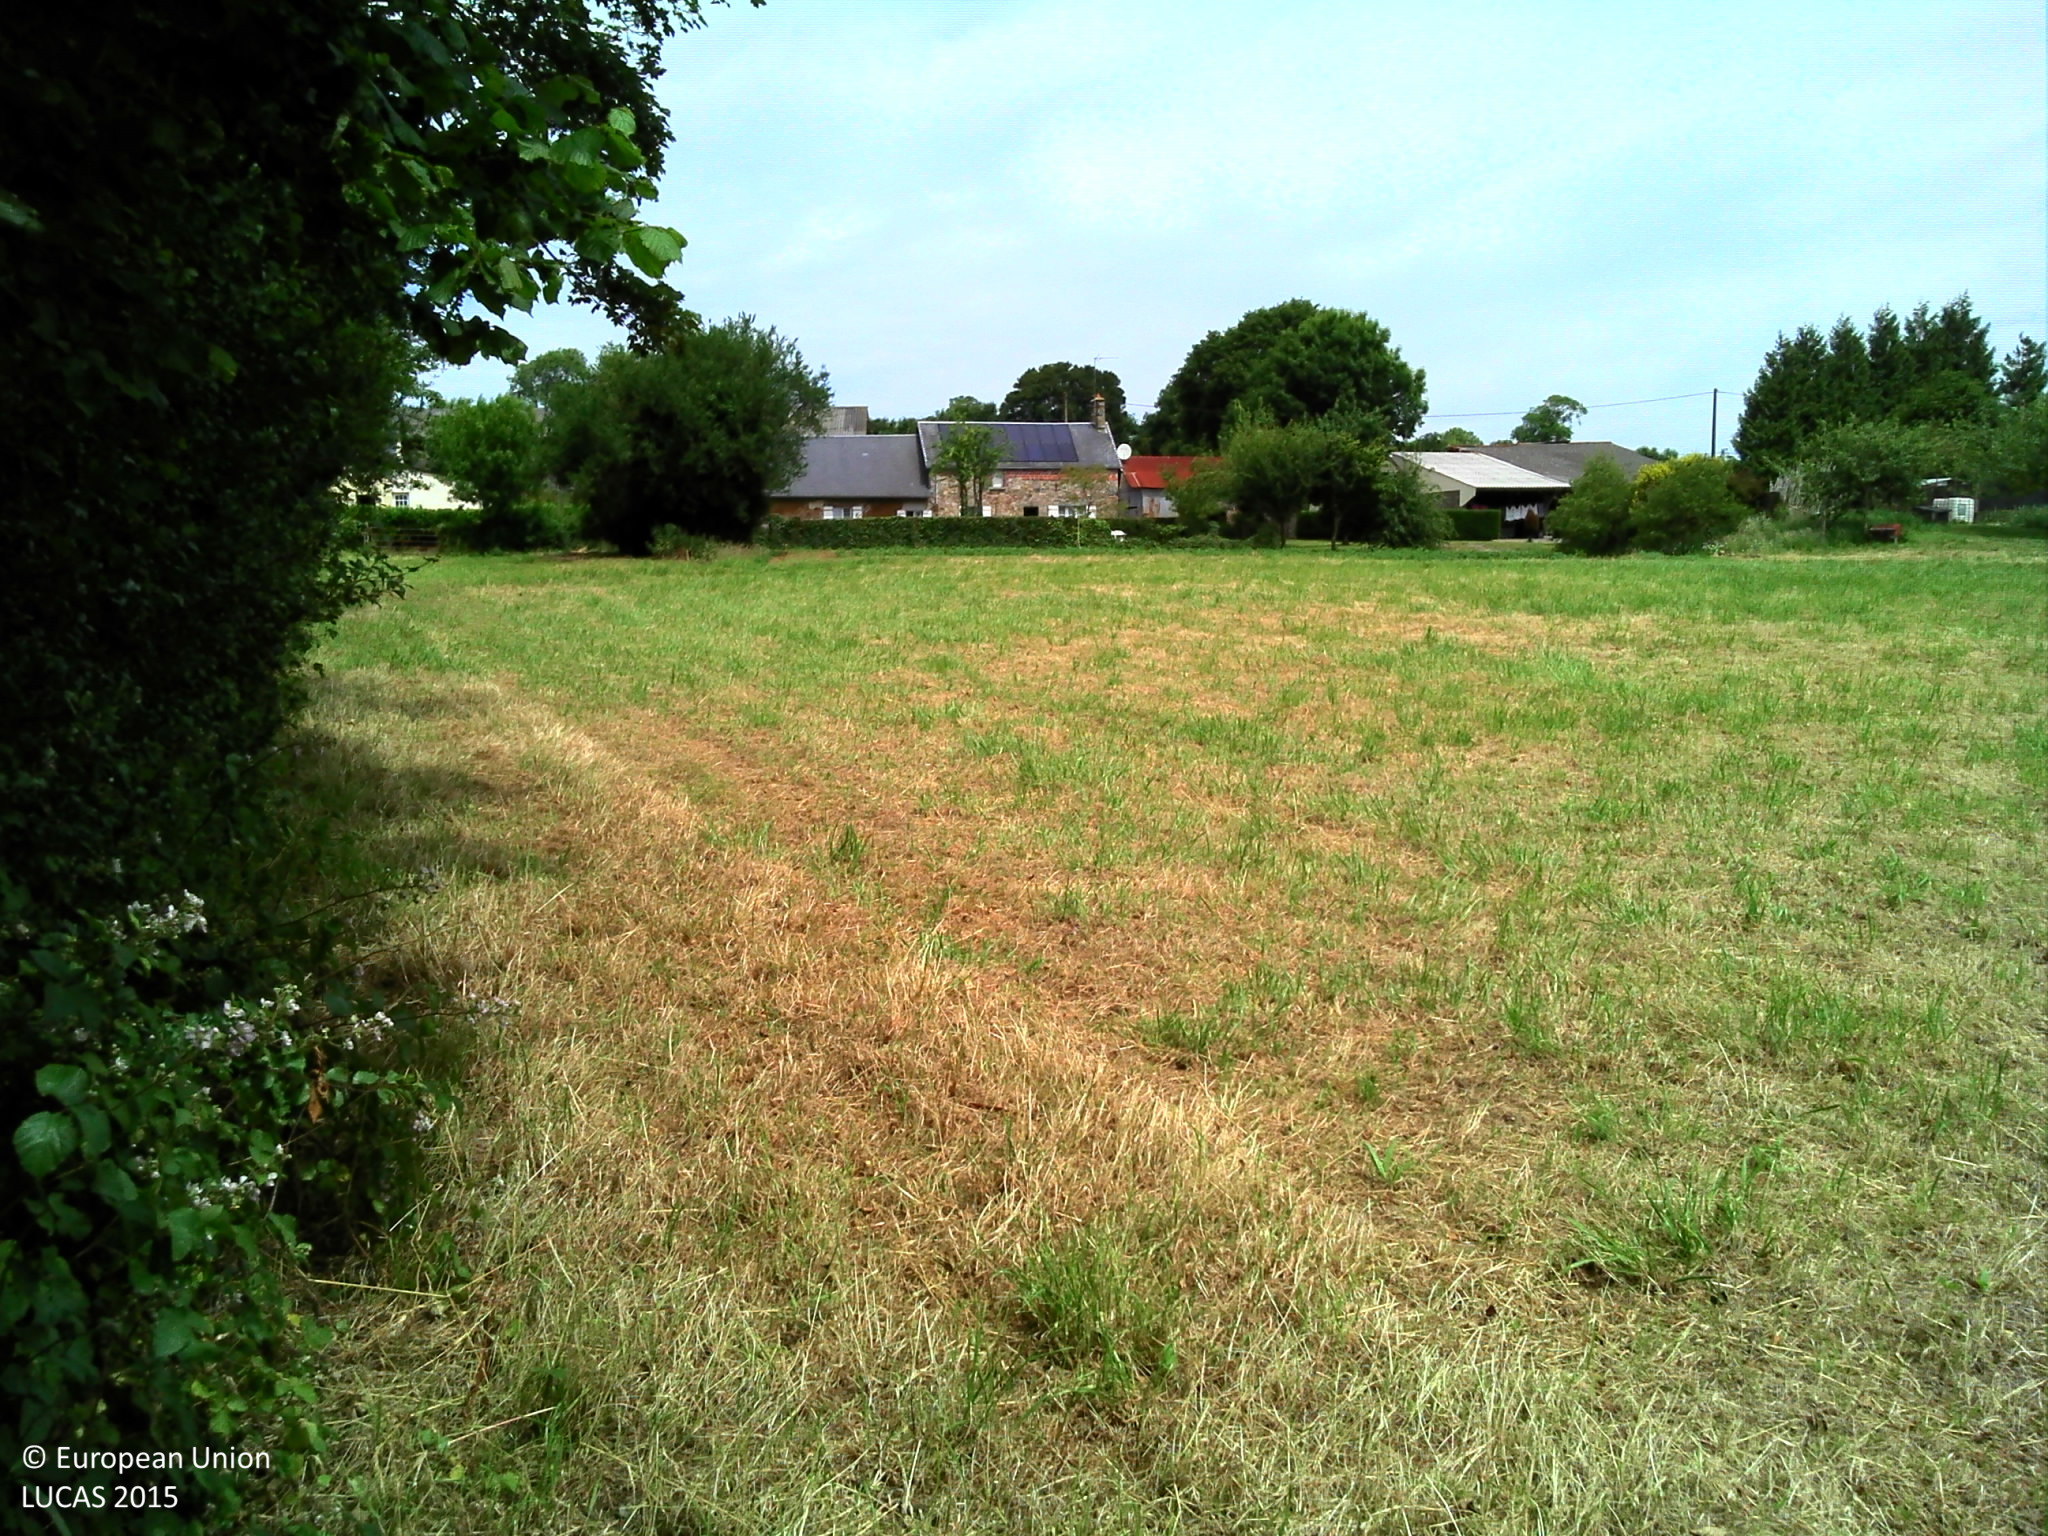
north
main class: Woodland
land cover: Broadleaved woodland
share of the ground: > 75 %
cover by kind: broadleaved forest trees 100 %
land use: Agriculture (excluding fallow land and kitchen gardens)
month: June
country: FR
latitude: 49.1286
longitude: -1.4917
